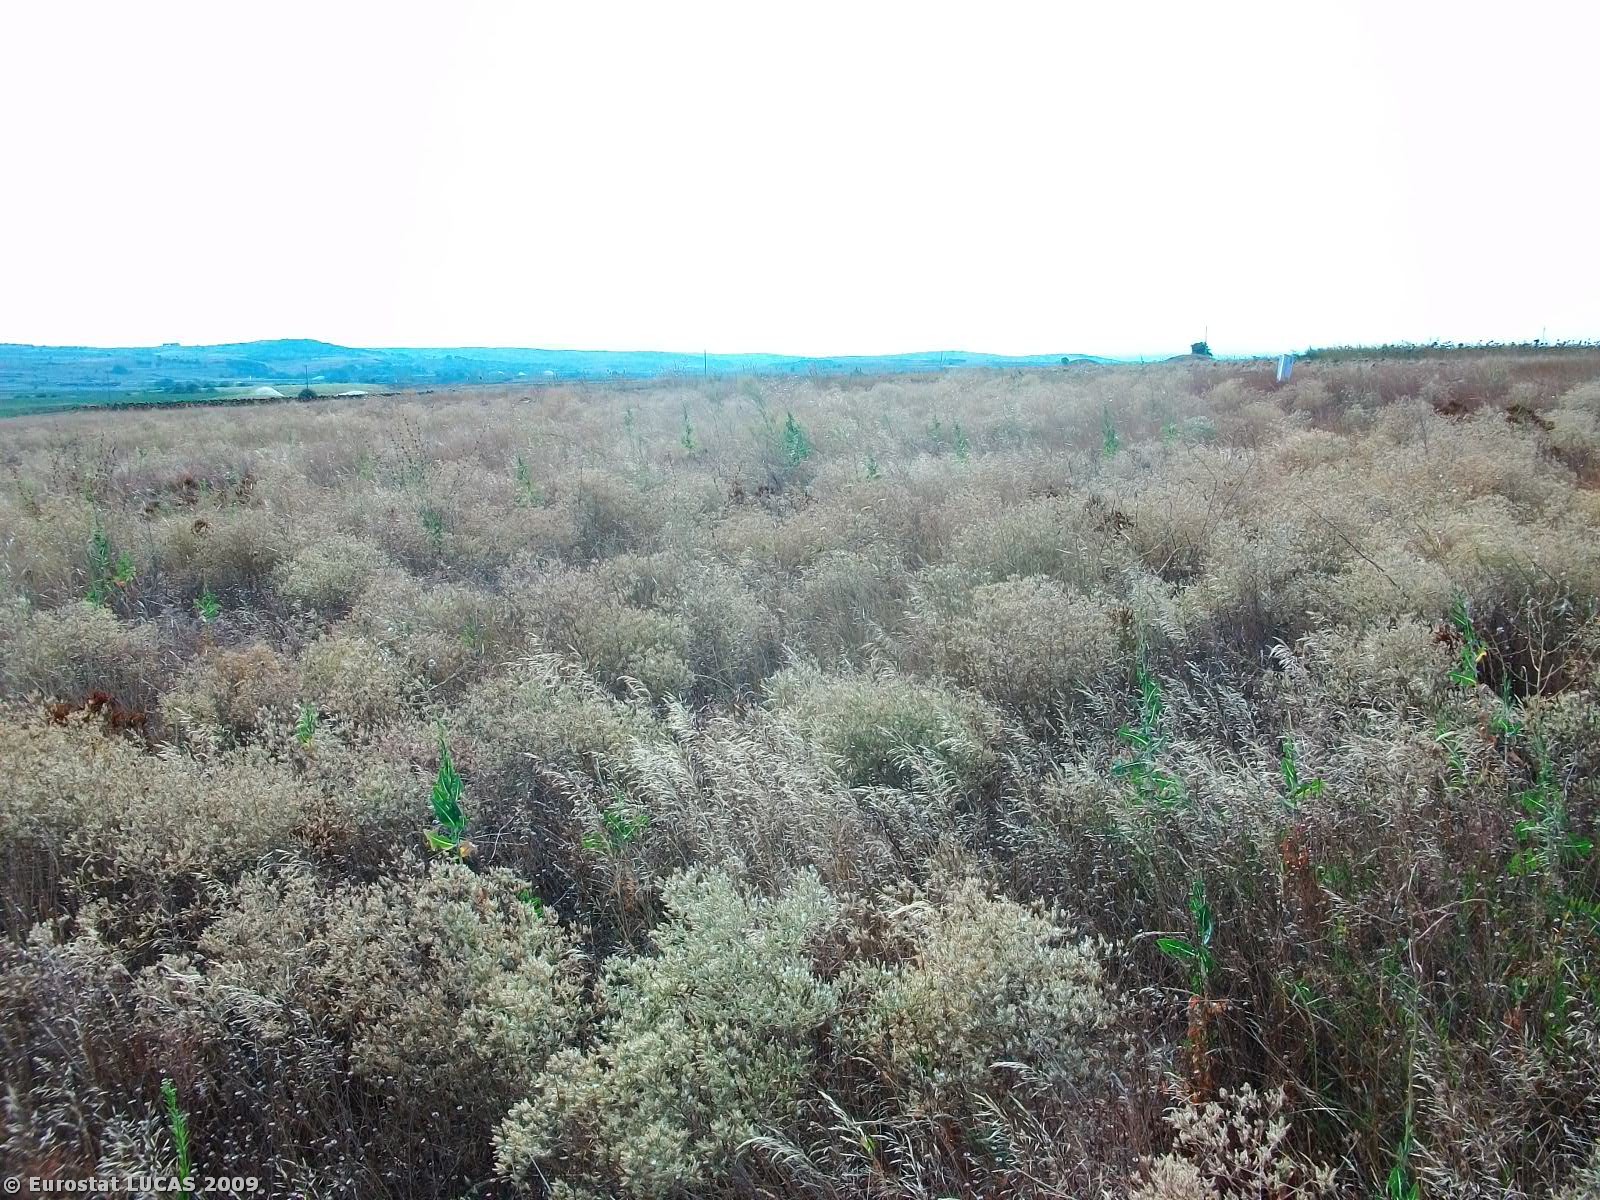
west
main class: Grassland
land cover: Grassland without tree/shrub cover
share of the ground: > 75 %
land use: Unused
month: August
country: GR
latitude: 41.5508
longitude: 26.3694
